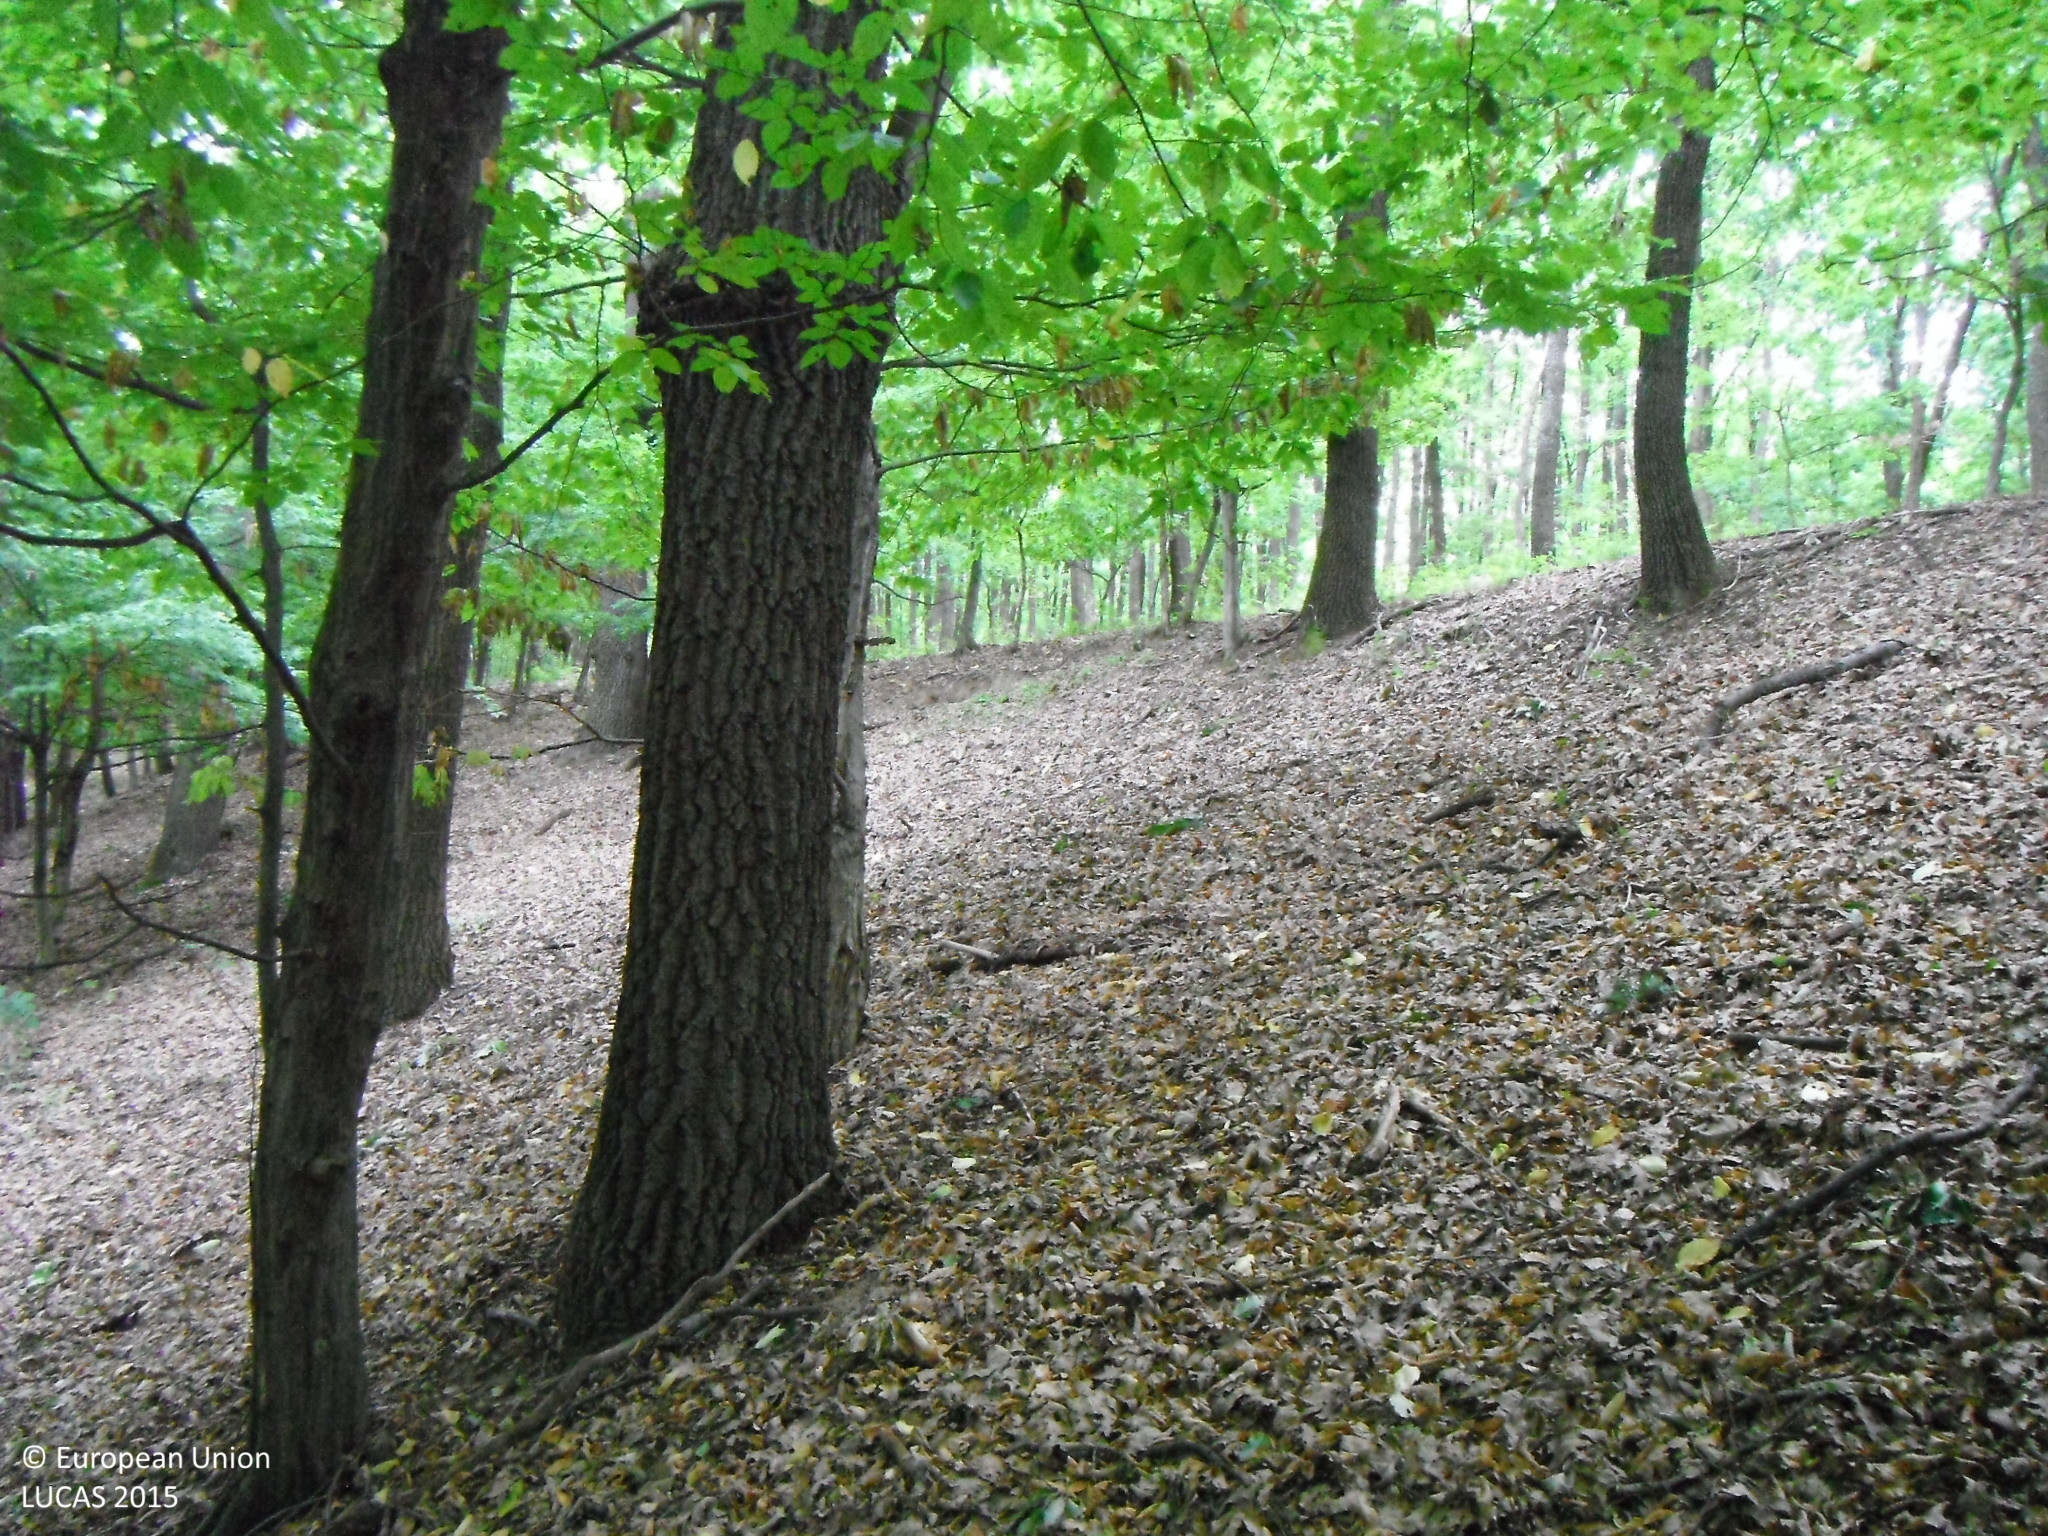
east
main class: Woodland
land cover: Broadleaved woodland
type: mesophytic deciduous forest
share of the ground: > 75 %
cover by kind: broadleaved forest trees 100 %
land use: Forestry
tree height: > 5 m
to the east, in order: Broadleaved woodland
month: July
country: SK
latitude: 48.1972
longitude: 19.8620
